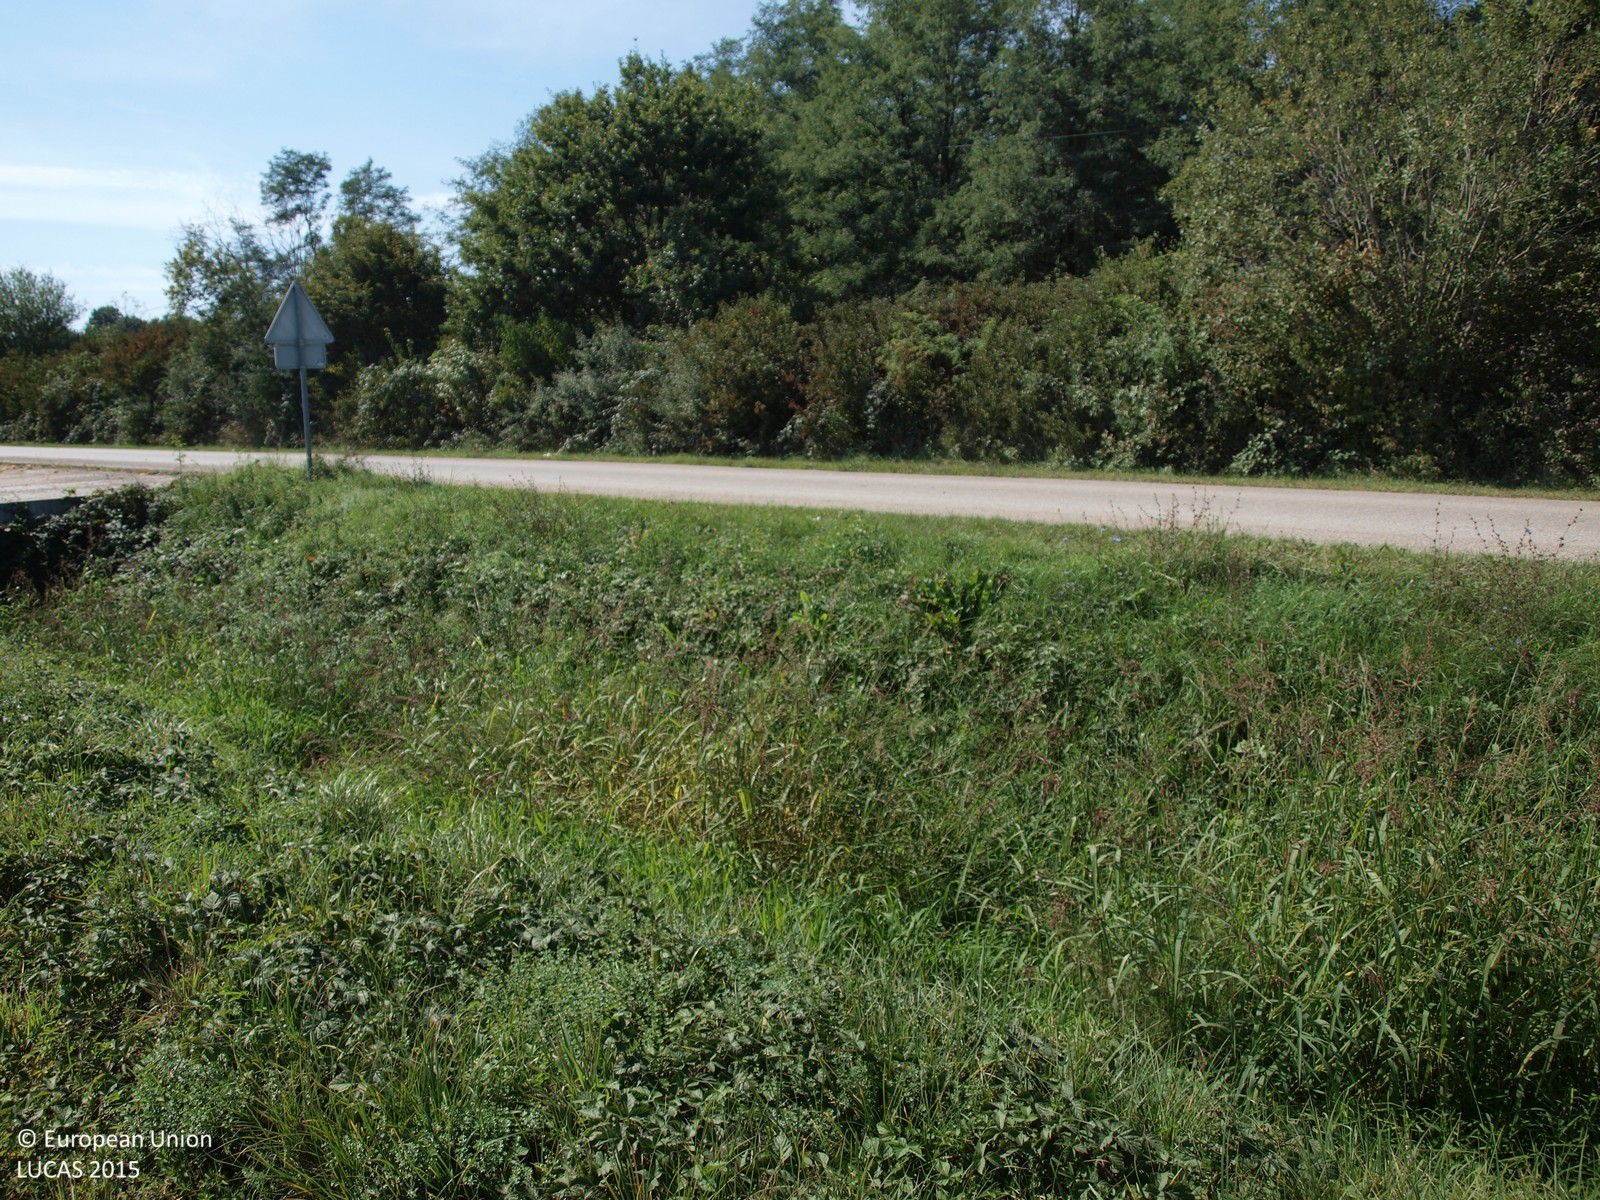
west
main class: Grassland
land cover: Grassland without tree/shrub cover
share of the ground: > 75 %
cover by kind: herbaceous plants 100 %
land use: Agriculture (excluding fallow land and kitchen gardens)
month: September
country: HR
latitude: 45.6536
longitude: 16.0932
